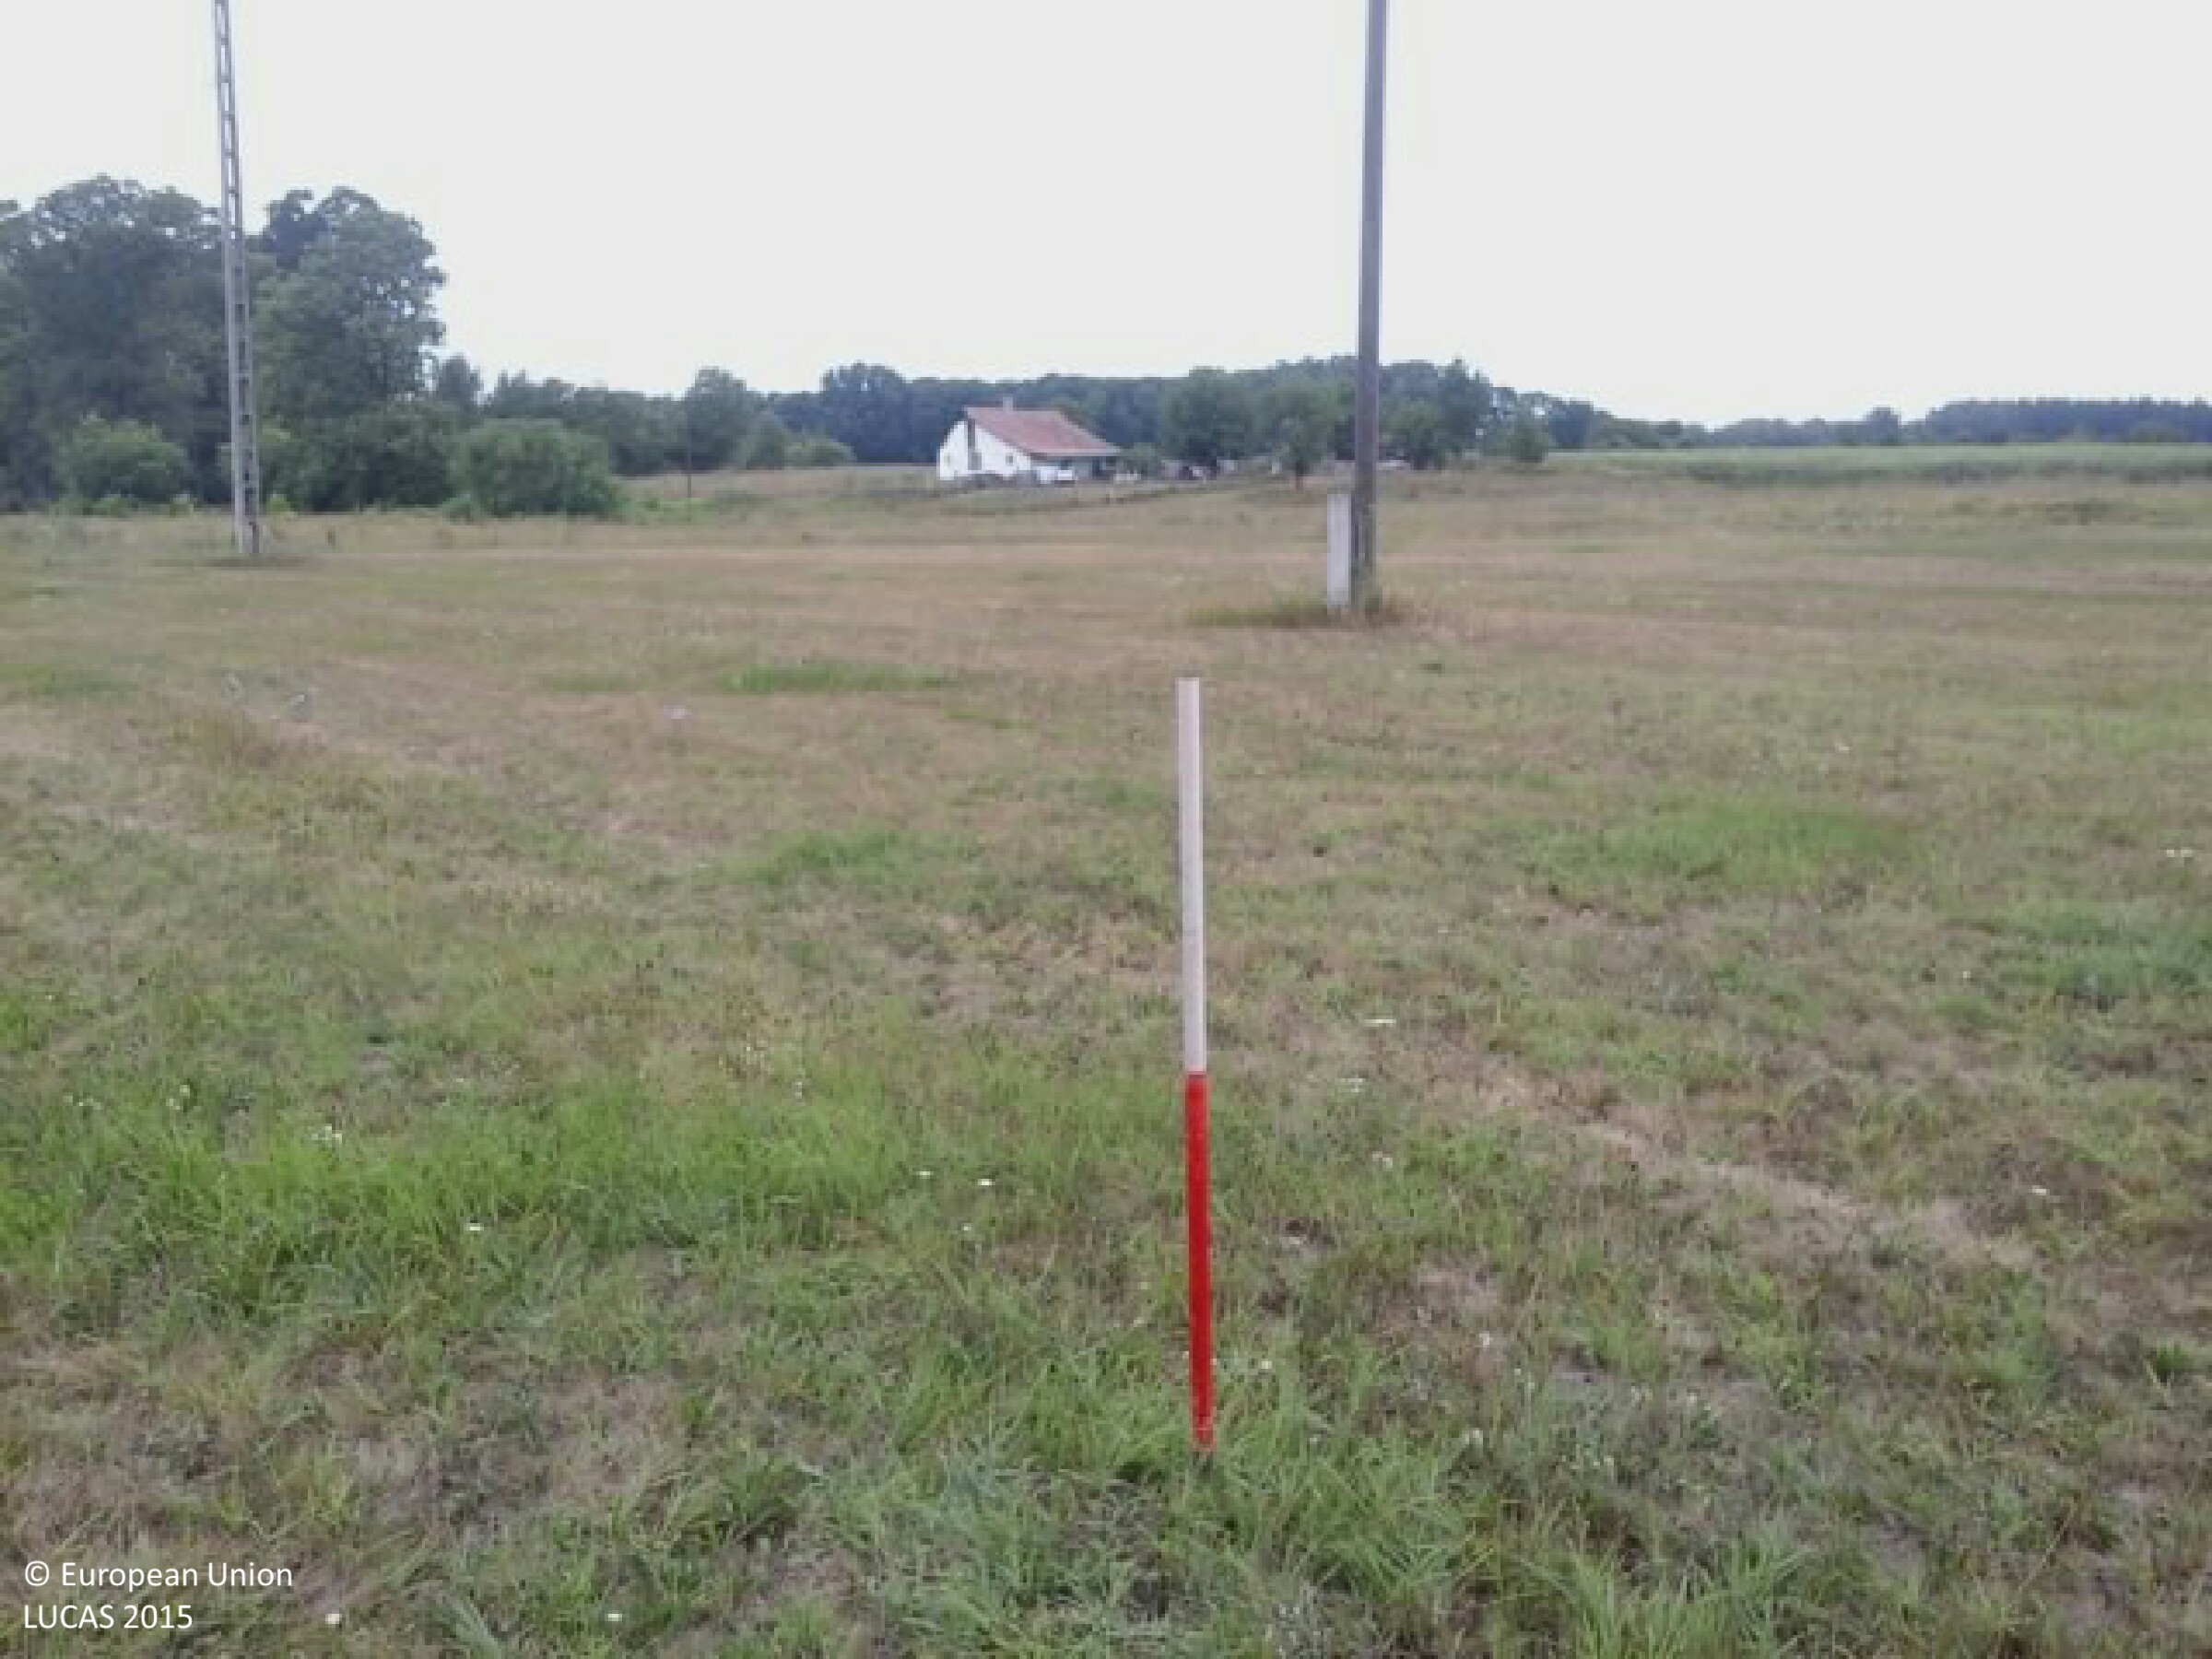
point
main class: Grassland
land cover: Grassland without tree/shrub cover
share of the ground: > 75 %
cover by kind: herbaceous plants 100 %
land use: Agriculture (excluding fallow land and kitchen gardens)
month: July
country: HU
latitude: 47.0473
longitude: 19.7491
